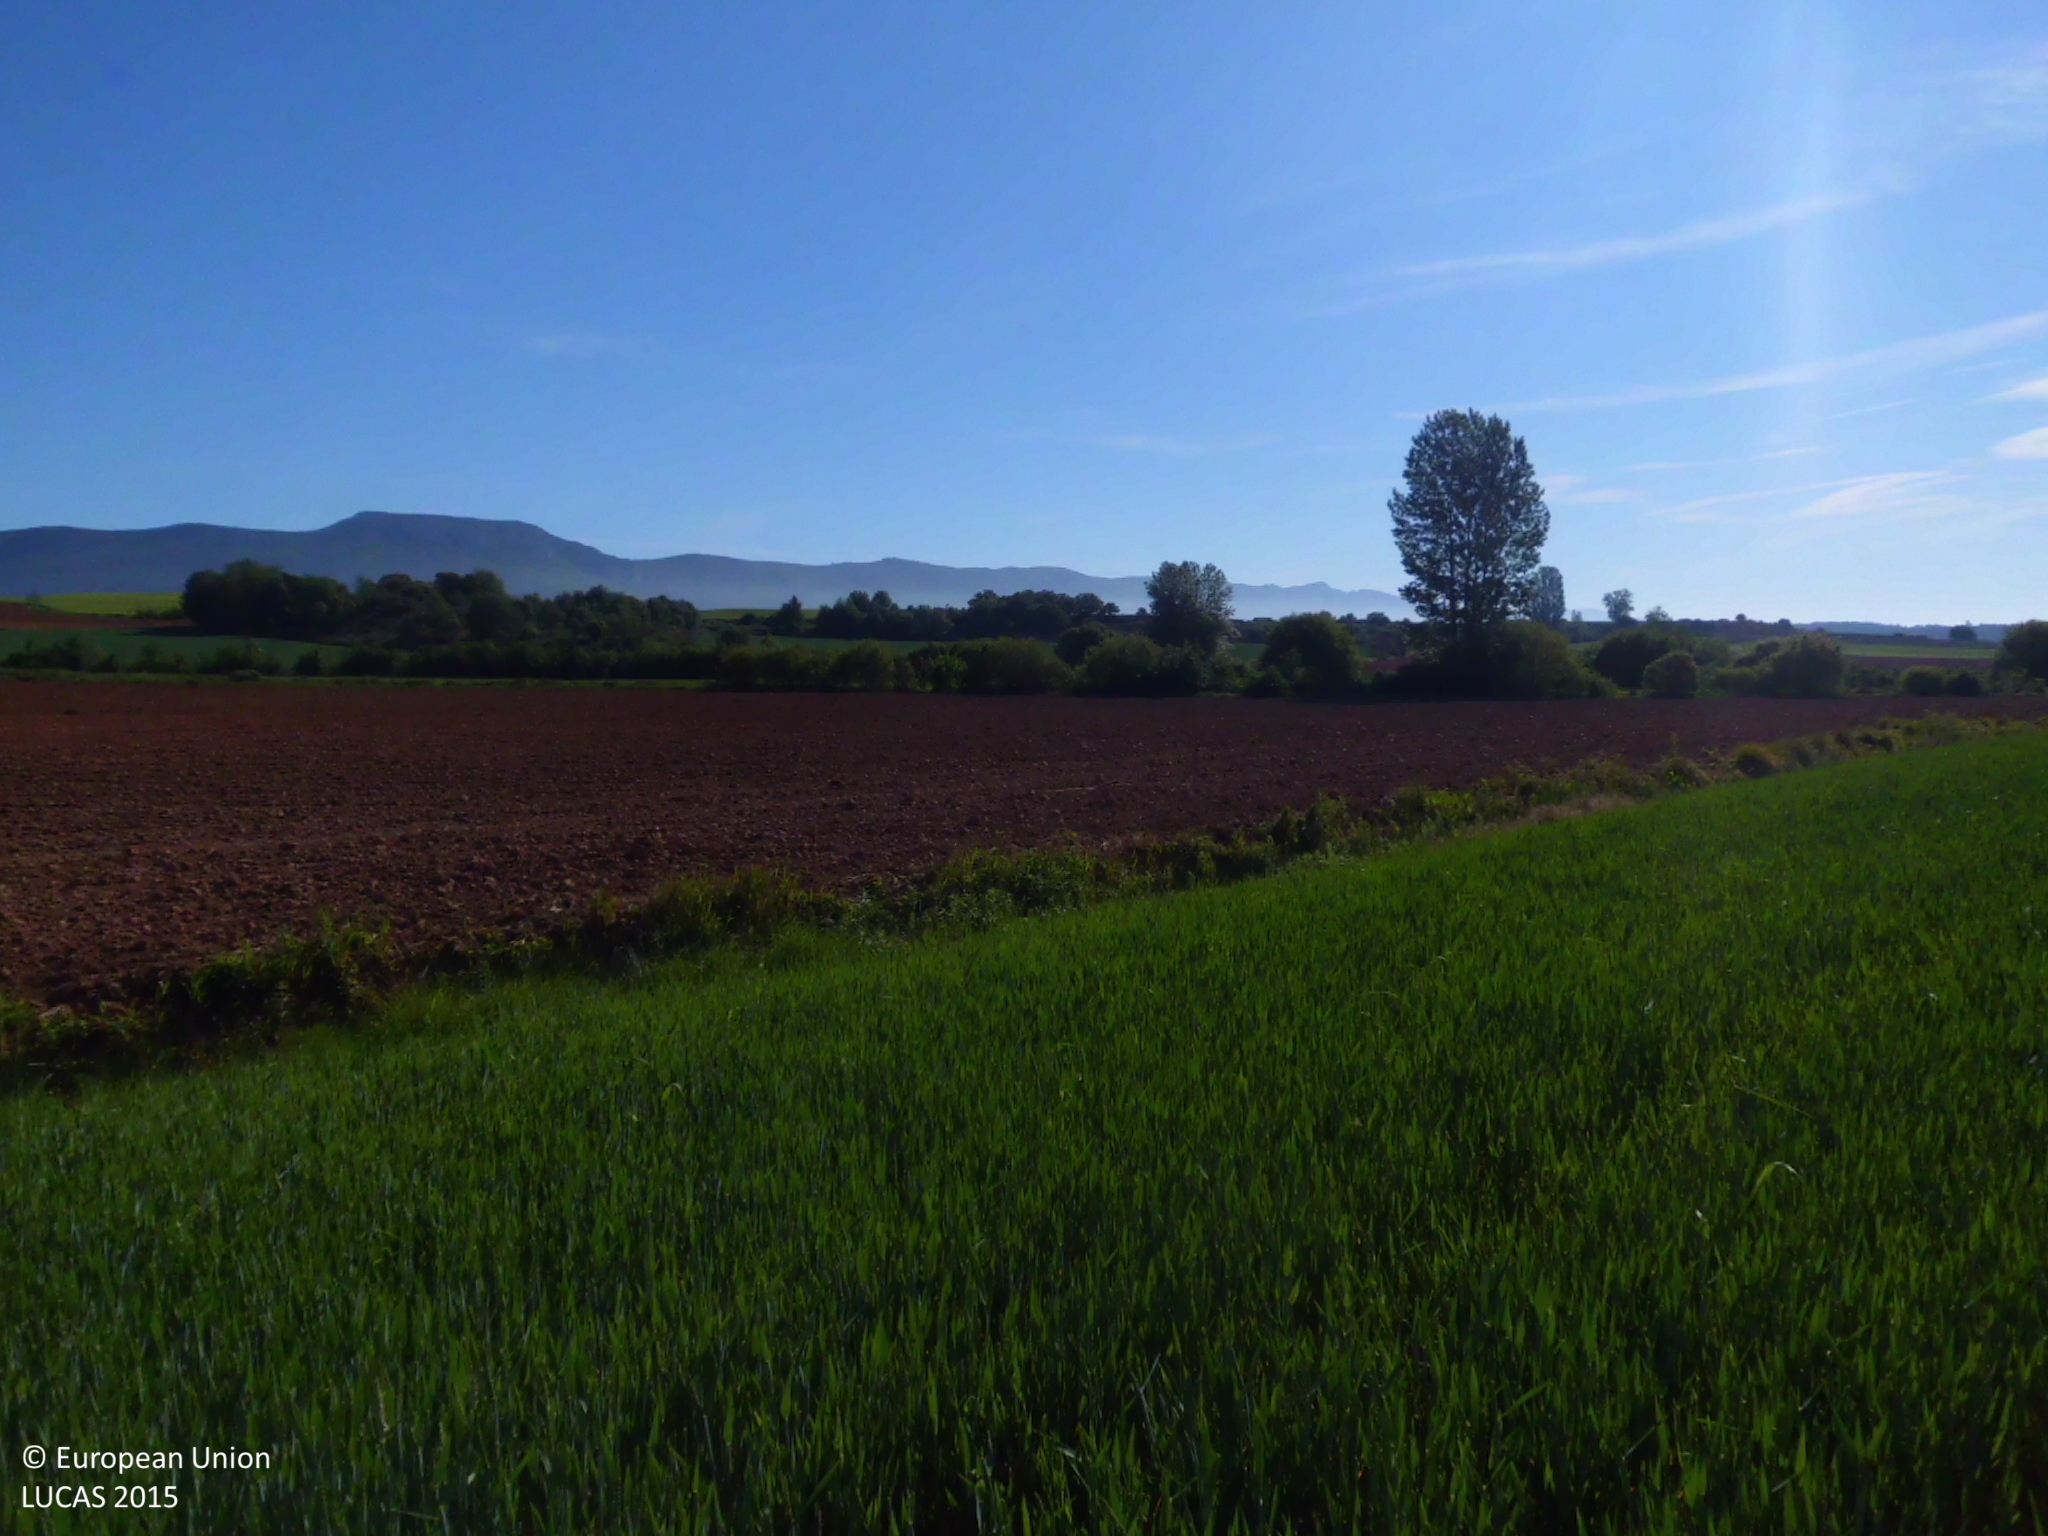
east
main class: Cropland
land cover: Common wheat
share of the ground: > 75 %
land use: Agriculture (excluding fallow land and kitchen gardens)
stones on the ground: 25 - 50 %
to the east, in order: Common wheat; Grass margins; Sunflower; Ditches and canals; Tracks; Grass margins; Common wheat; Tracks; Sunflower; Grass margins; Sunflower
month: May
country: ES
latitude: 42.6671
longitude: -3.4447
